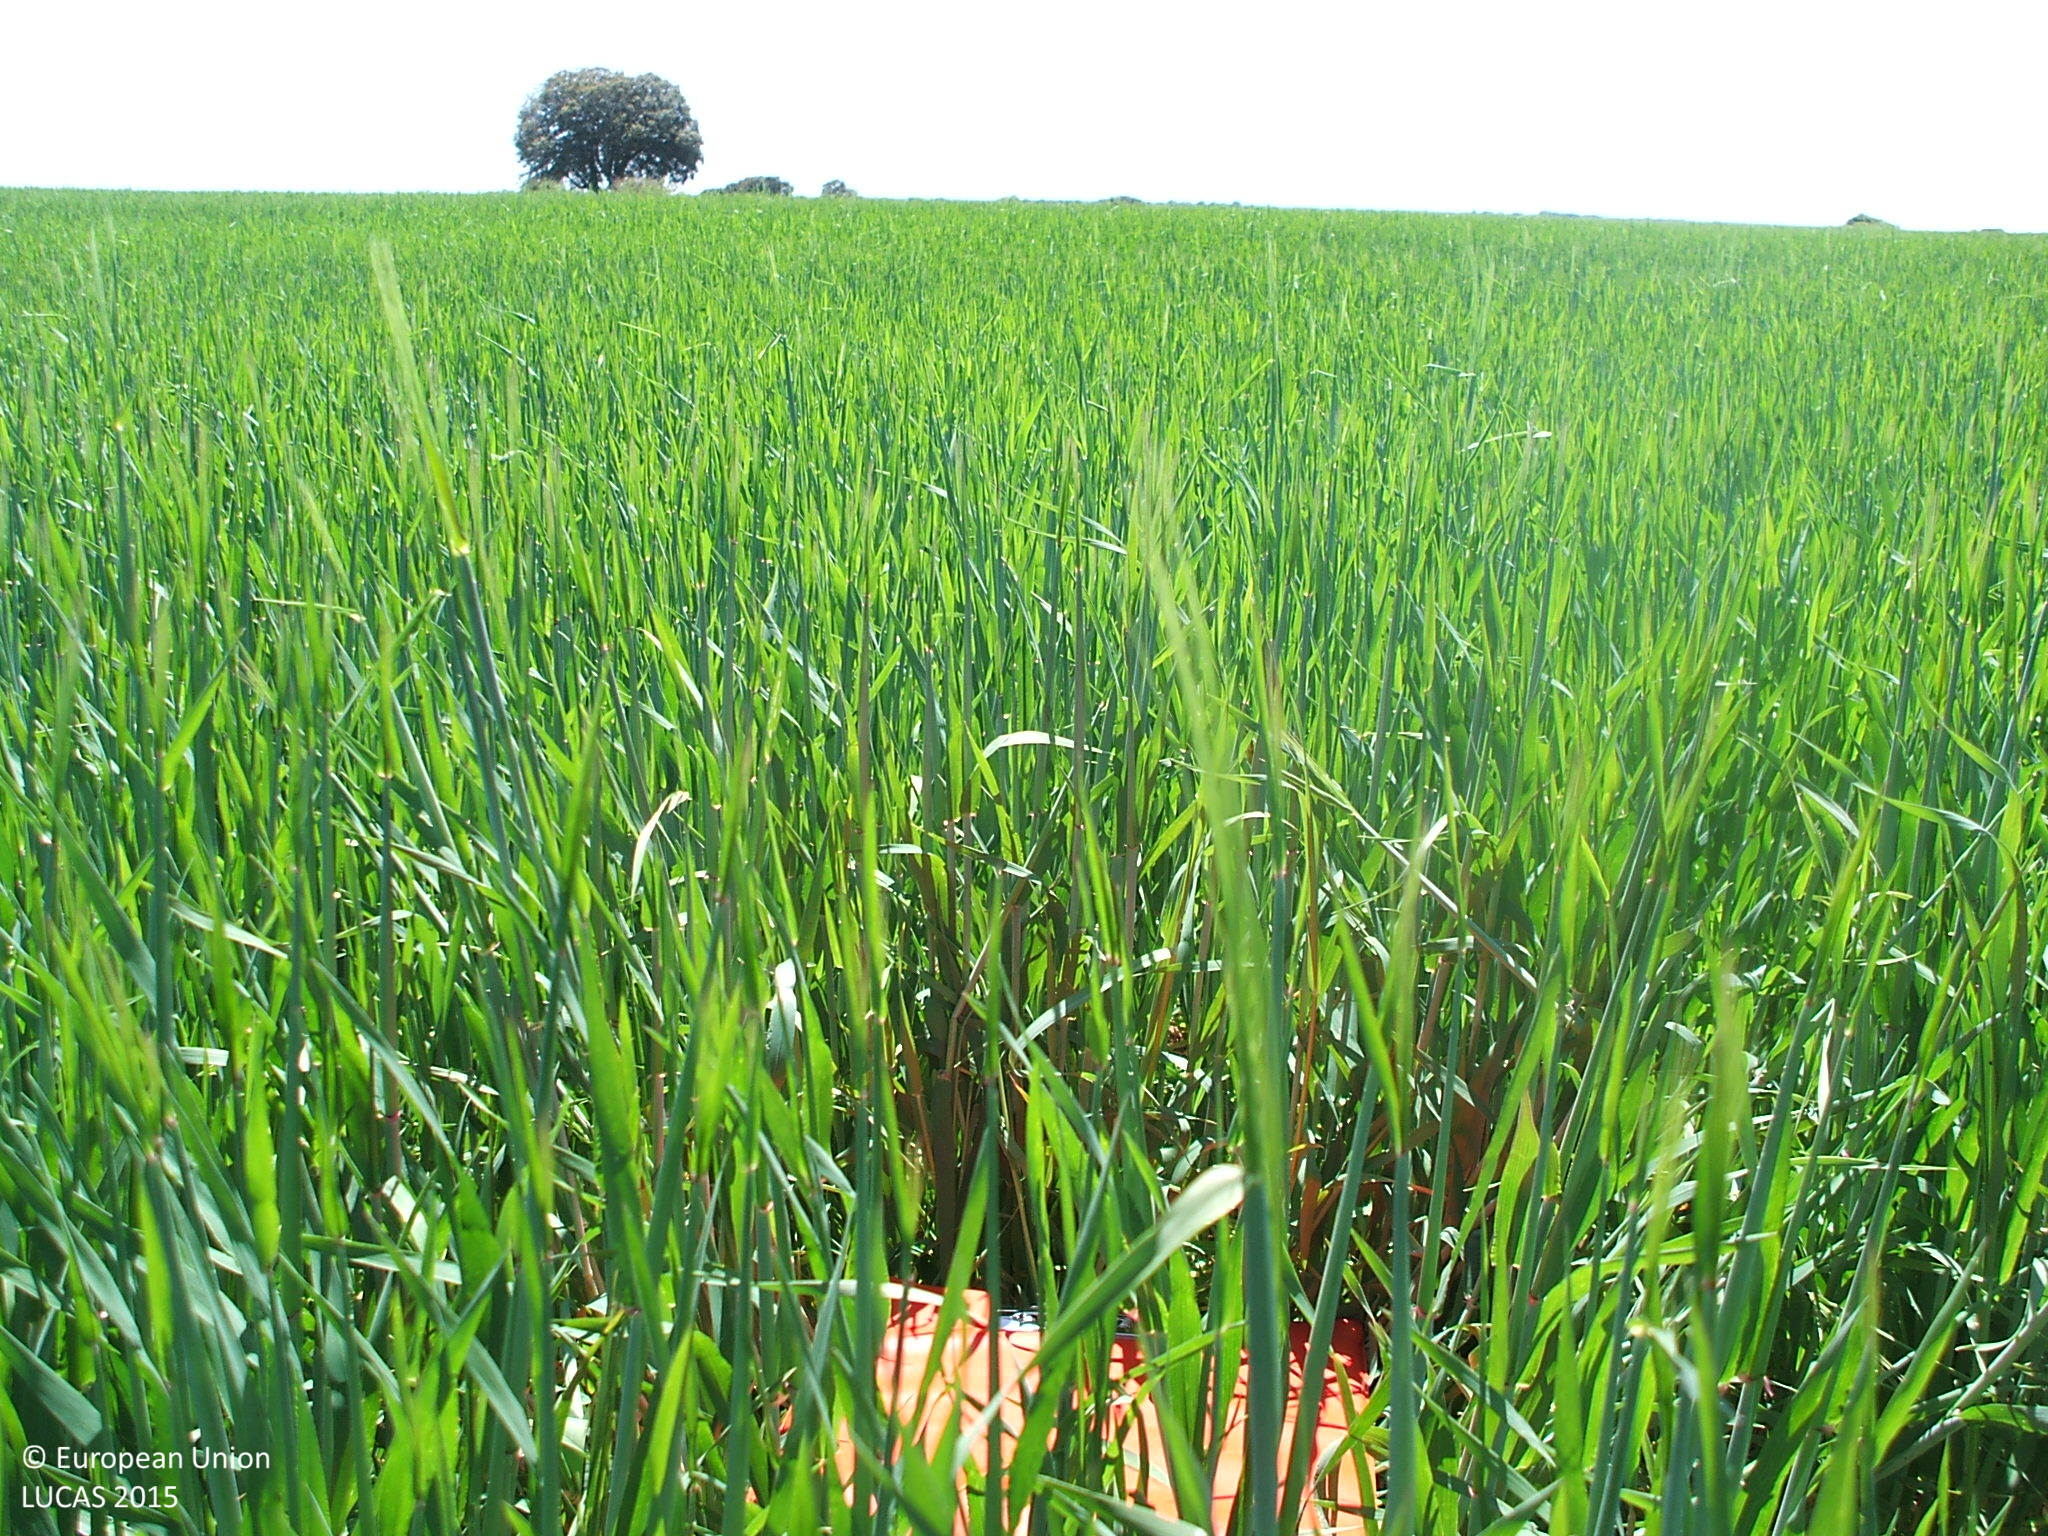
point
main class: Cropland
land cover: Barley
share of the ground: > 75 %
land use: Agriculture (excluding fallow land and kitchen gardens)
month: May
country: ES
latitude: 40.7047
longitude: -2.9445
